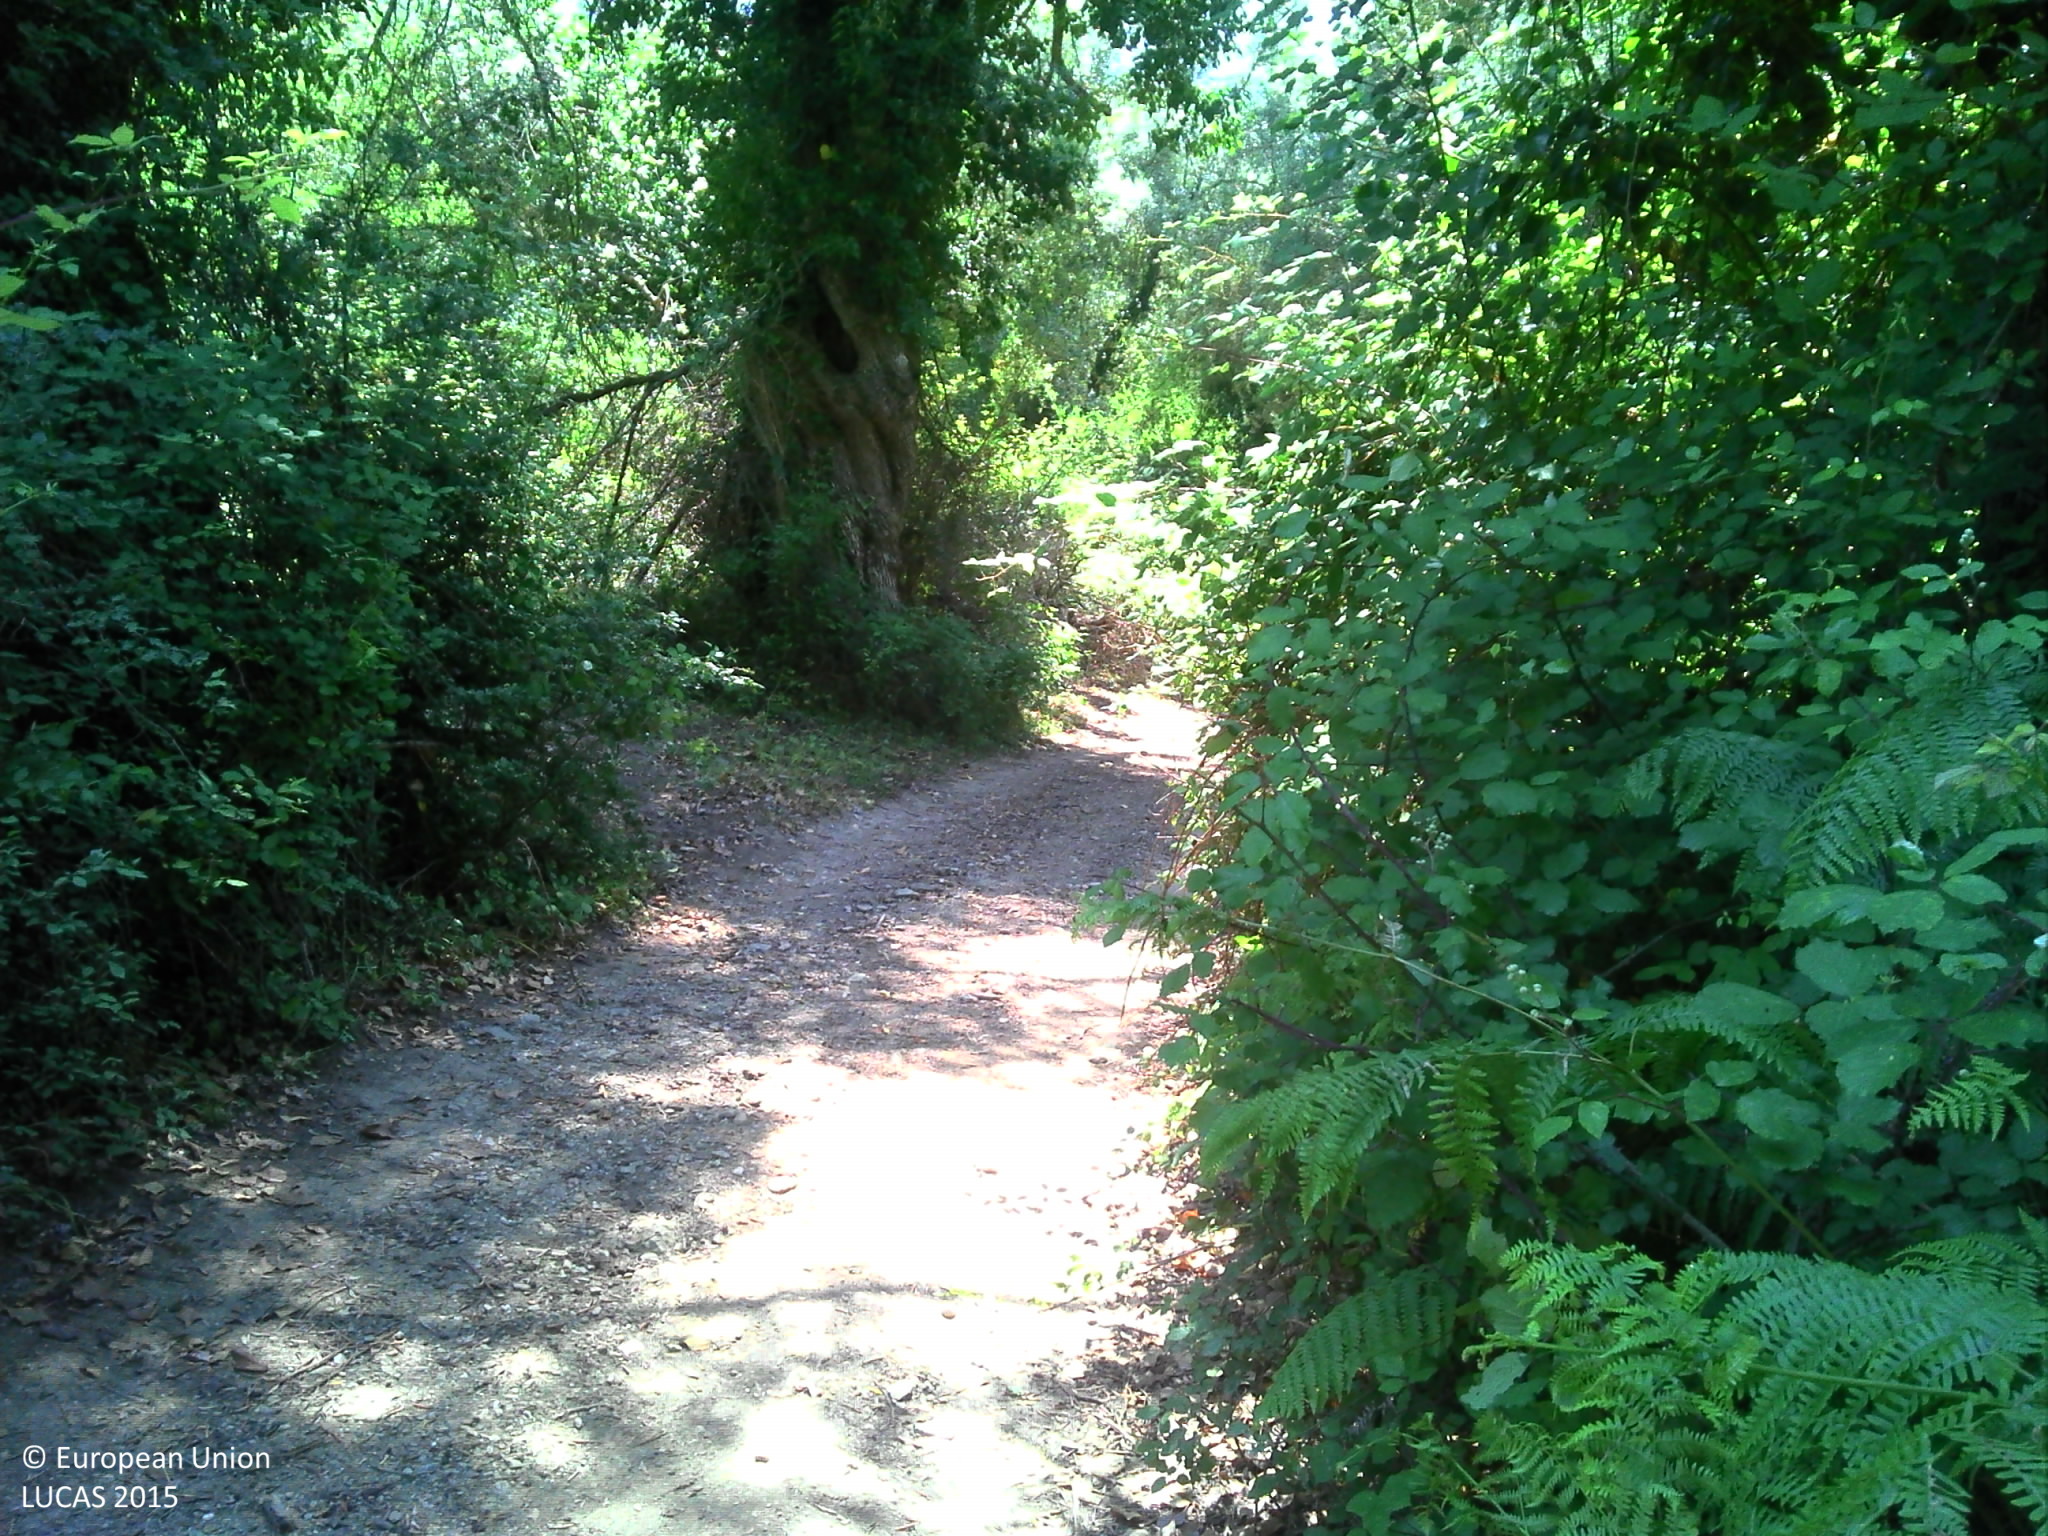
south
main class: Woodland
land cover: Broadleaved woodland
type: broadleaved evergreen forest
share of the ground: > 75 %
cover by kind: broadleaved forest trees 80 %, shrubs 20 %
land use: Forestry
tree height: > 5 m
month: June
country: FR
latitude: 42.5973
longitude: 9.2834
